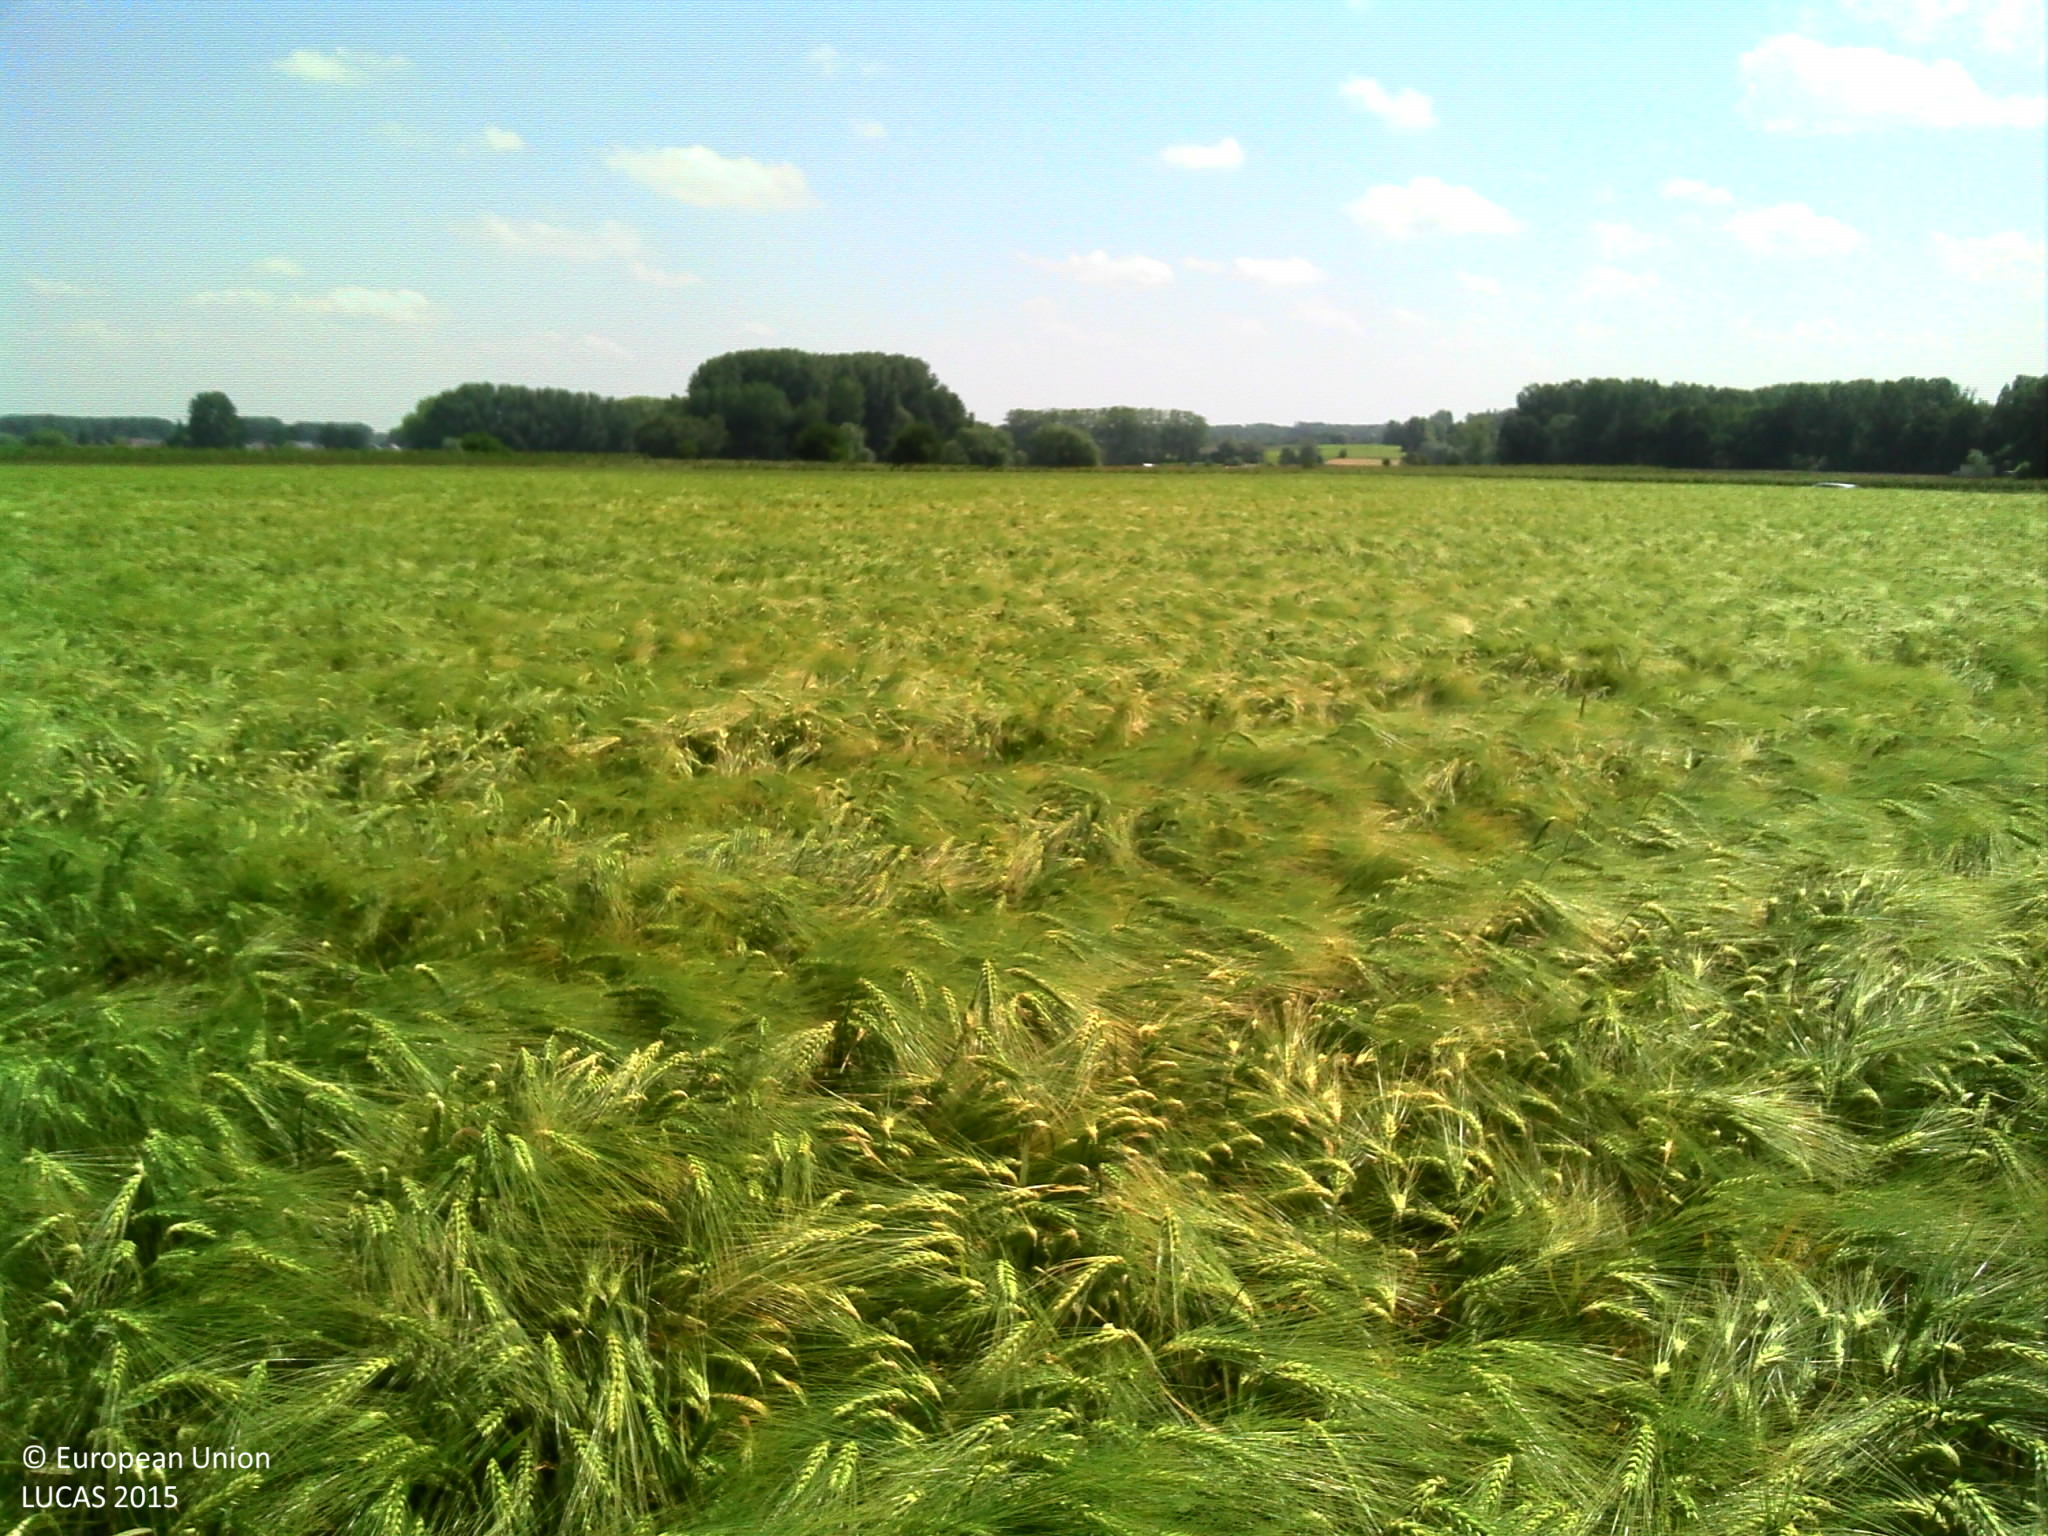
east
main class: Cropland
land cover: Barley
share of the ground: > 75 %
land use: Agriculture (excluding fallow land and kitchen gardens)
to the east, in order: Barley; Grass margins; Tracks; Nurseries; Fences; Nurseries; Fences; Other bare soil; Nurseries; Tracks; Nurseries
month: June
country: BE
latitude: 50.9594
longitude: 3.9145
